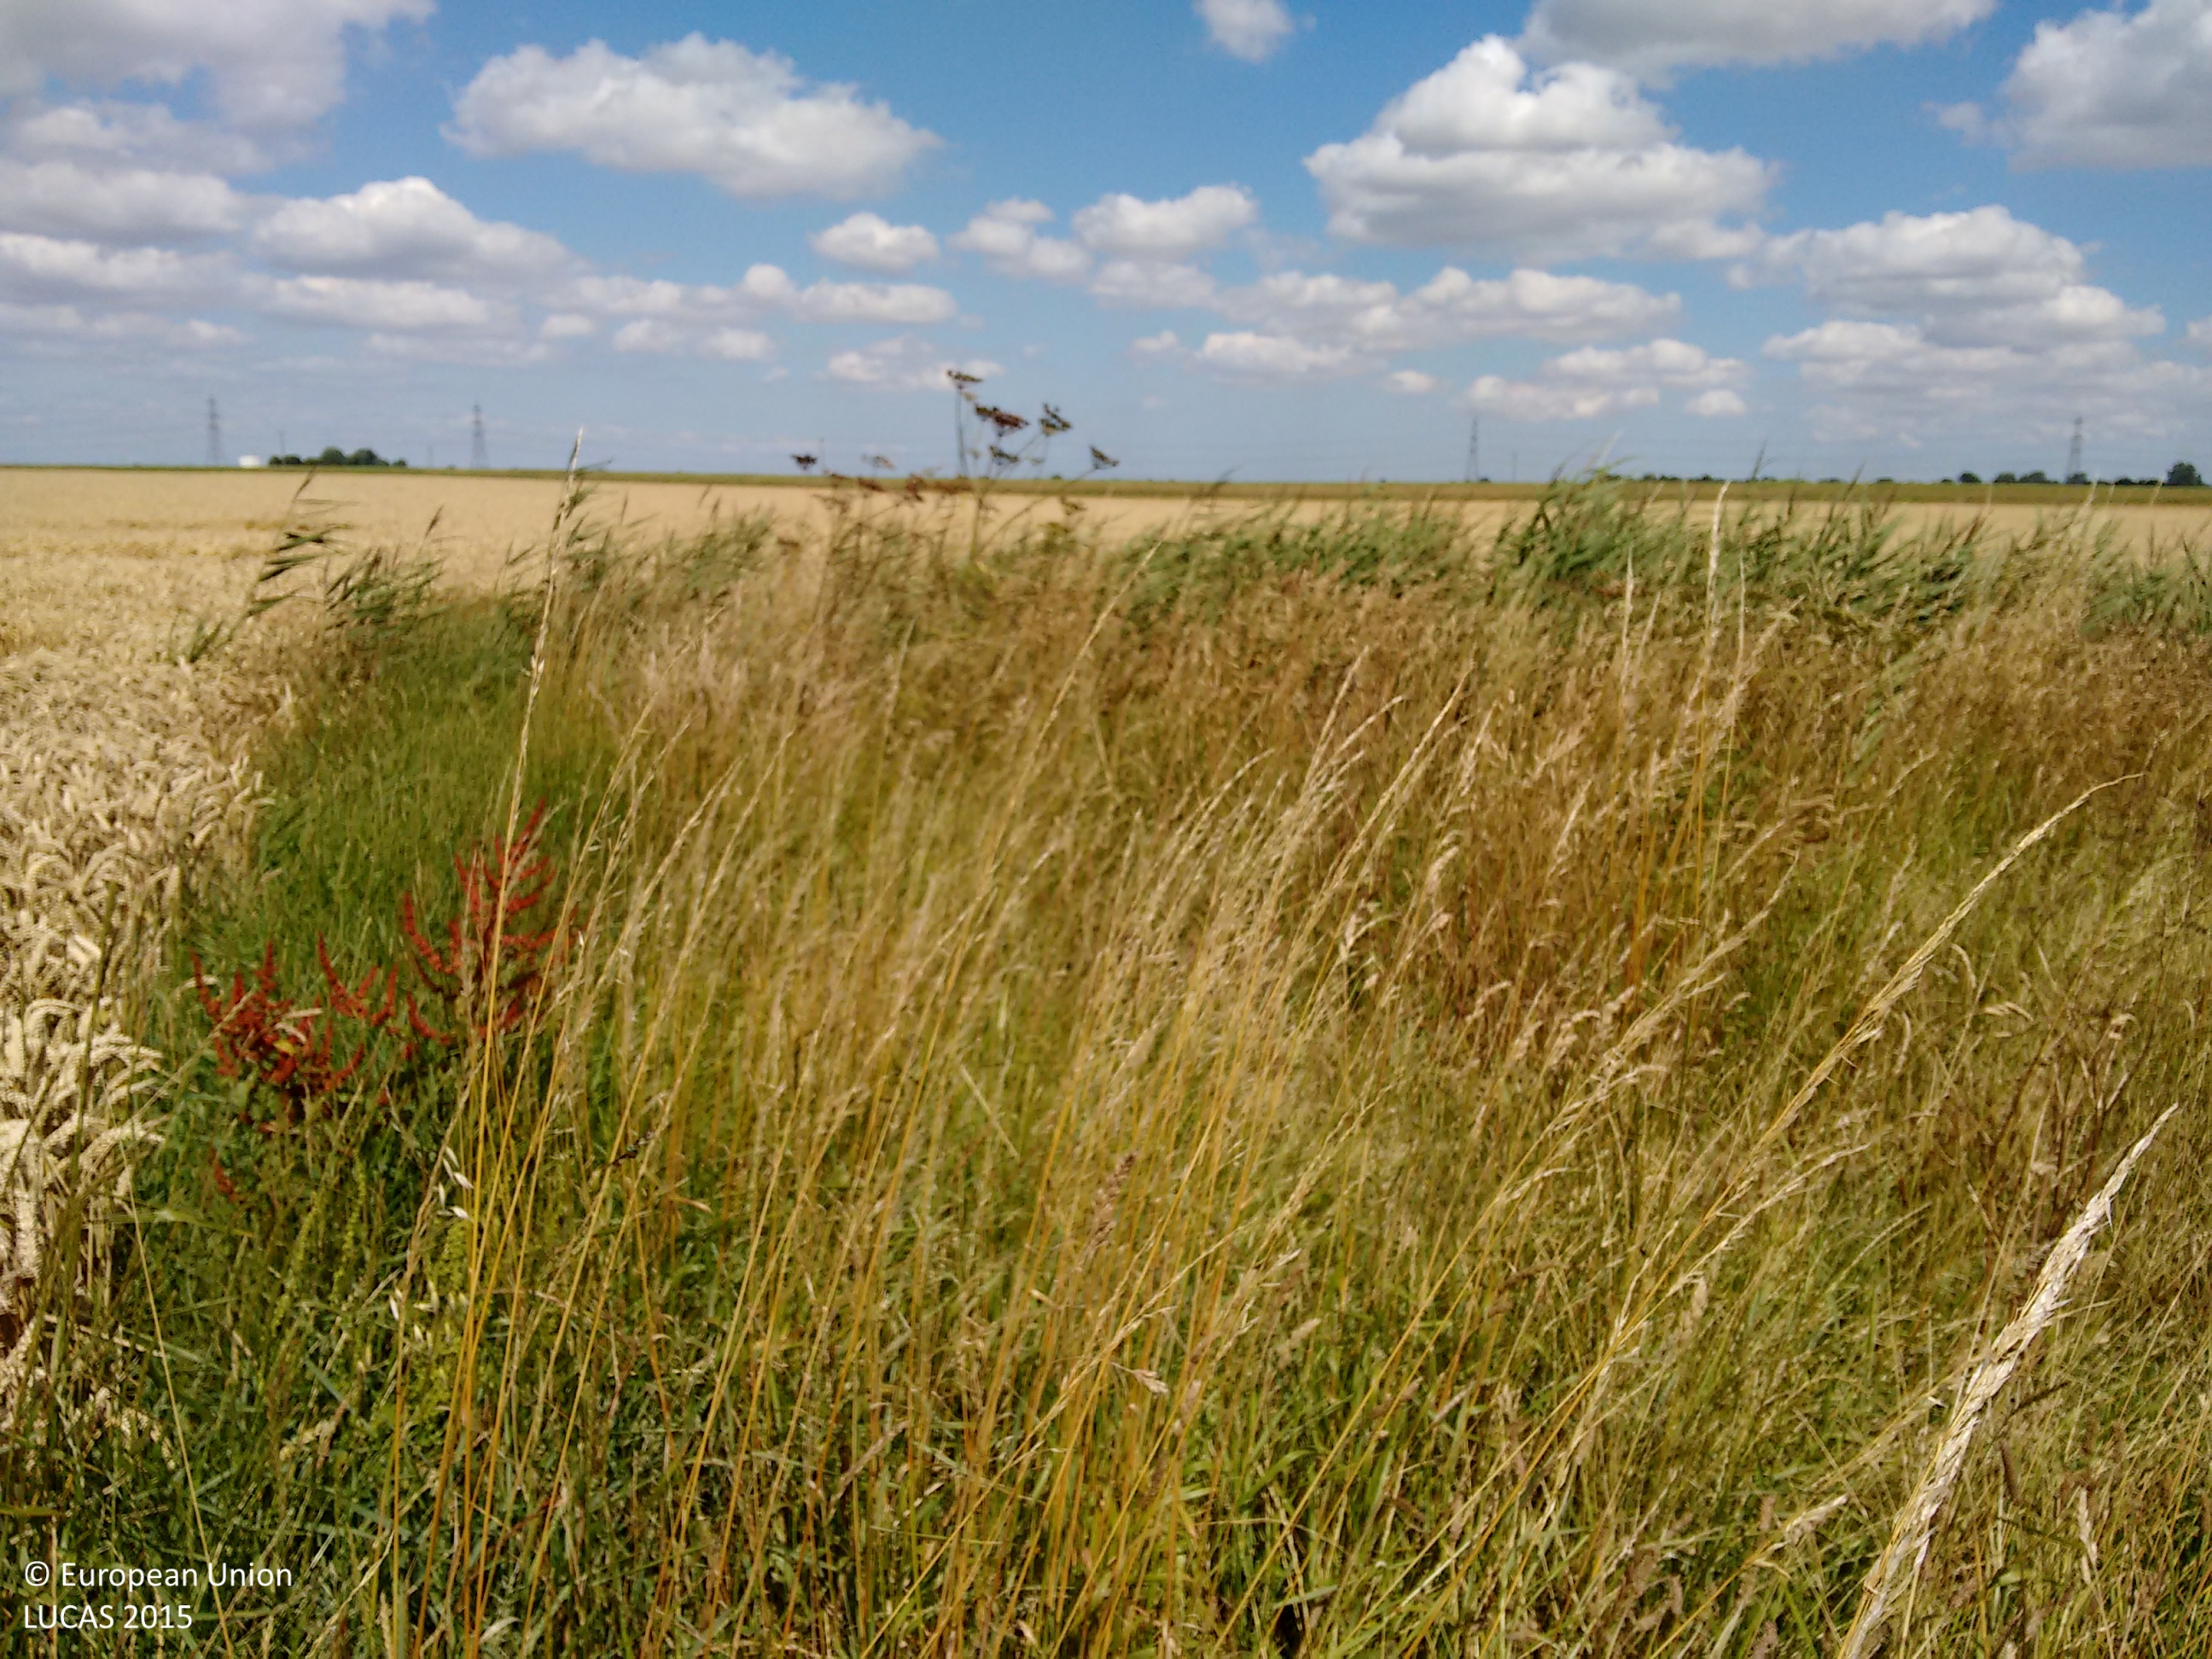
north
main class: Cropland
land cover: Common wheat
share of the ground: > 75 %
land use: Agriculture (excluding fallow land and kitchen gardens)
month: July
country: GB
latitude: 52.6937
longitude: 0.3986
